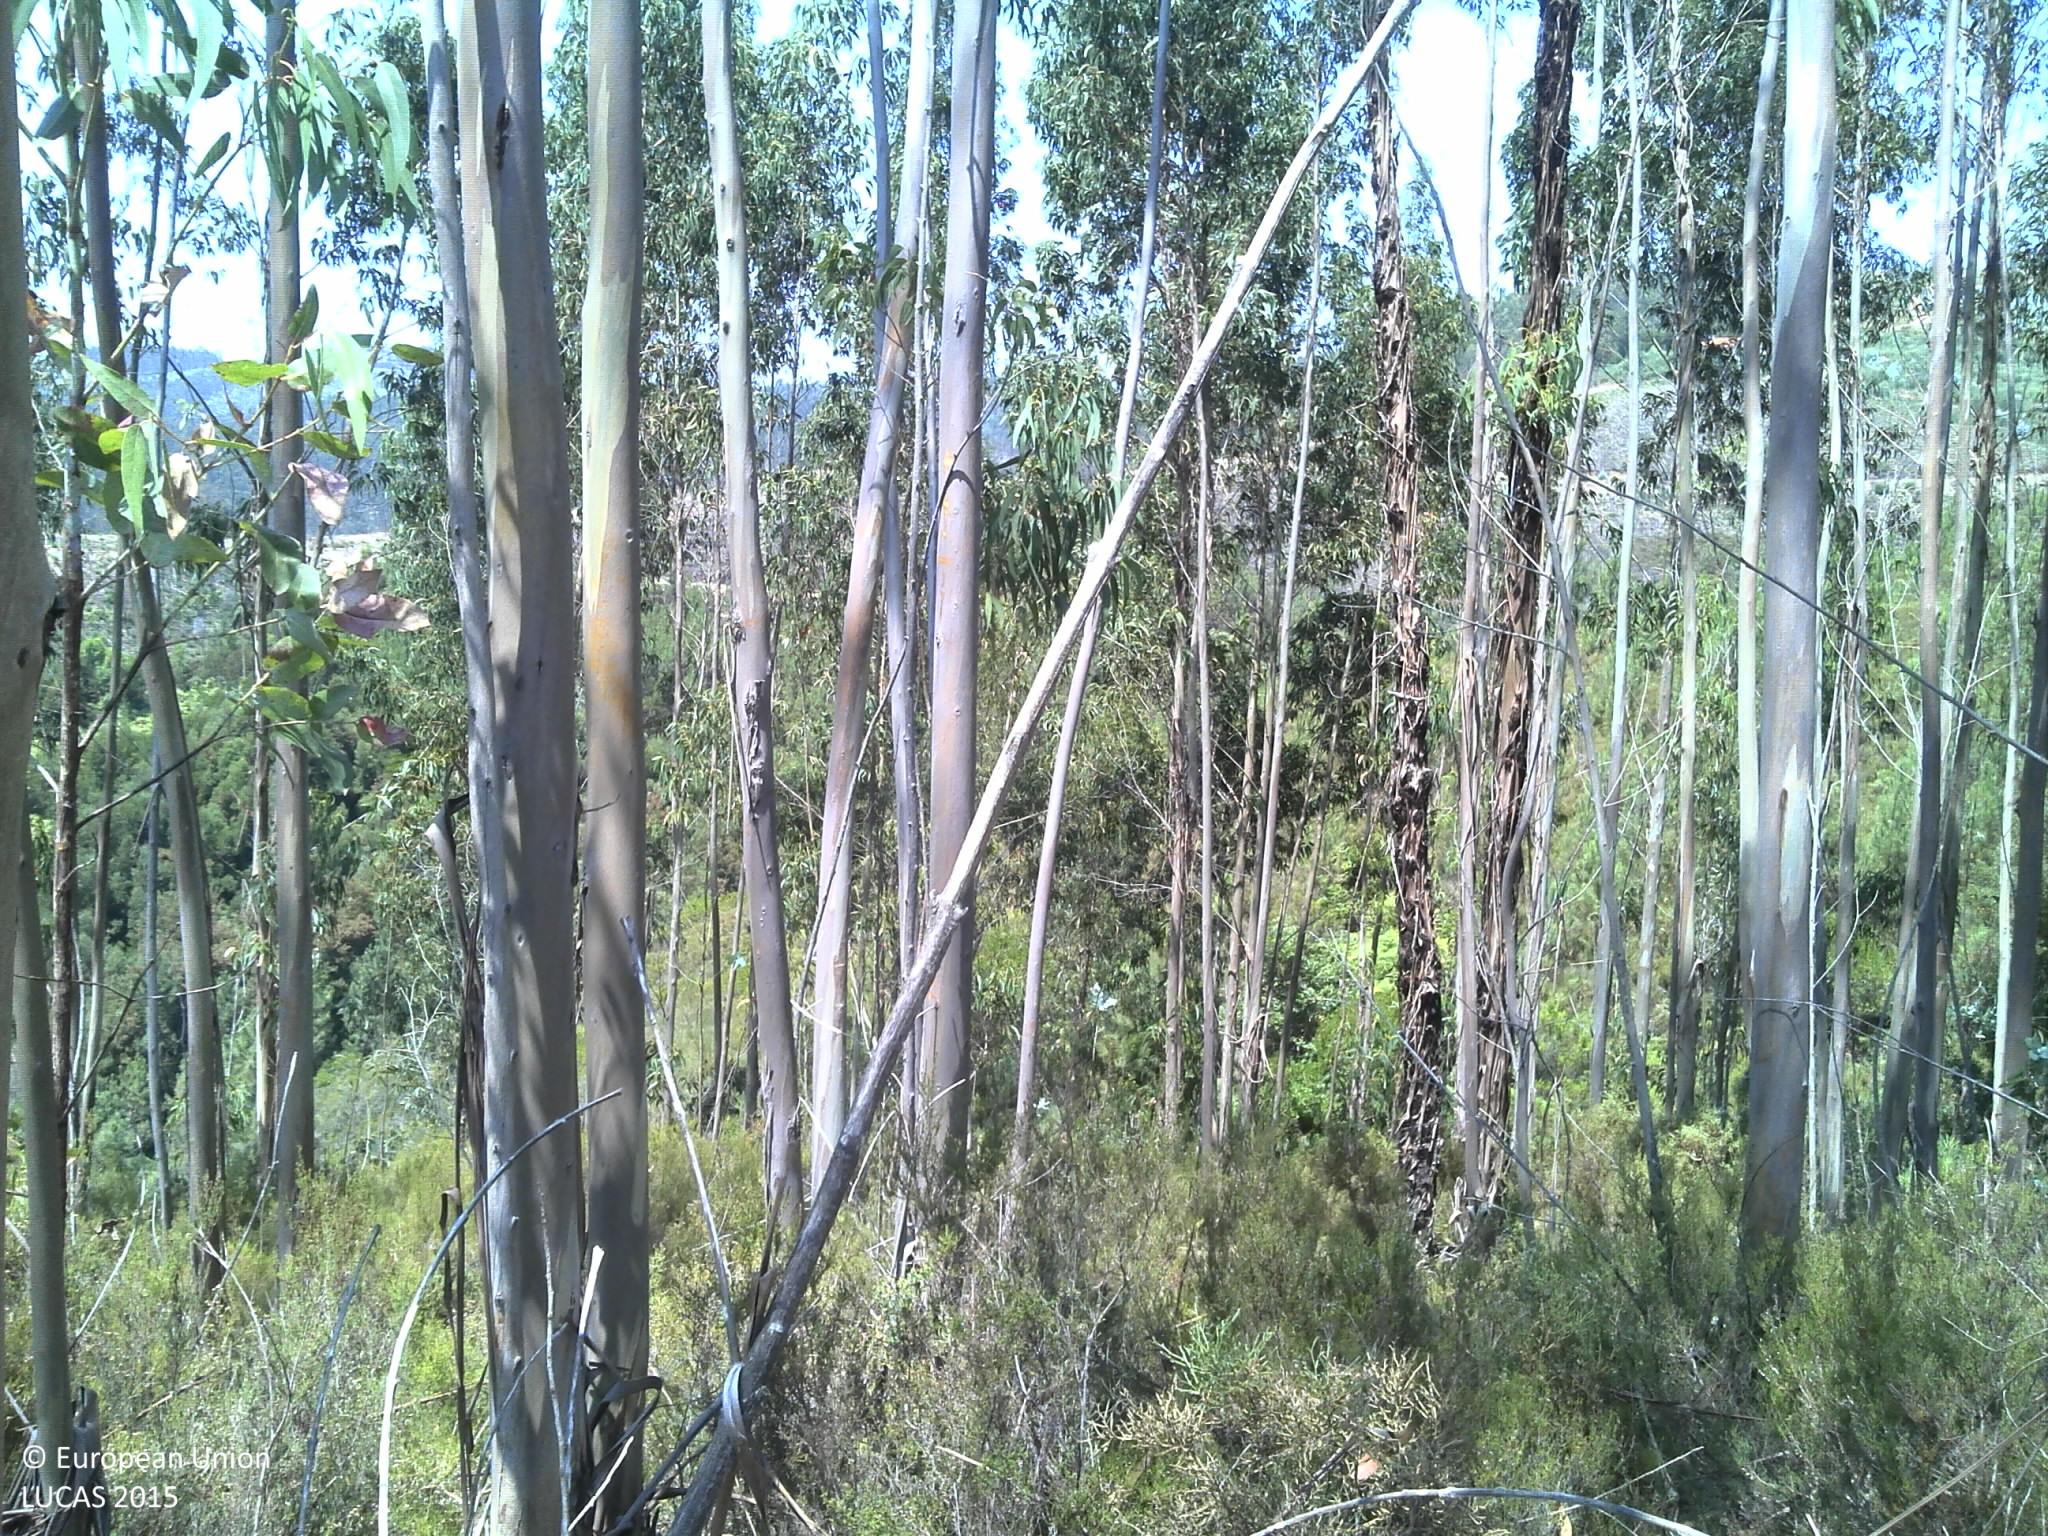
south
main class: Woodland
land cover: Broadleaved woodland
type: exotic forest
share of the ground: 50 - 75 %
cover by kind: broadleaved forest trees 70 %, shrubs 25 %, unconsolidated bare surface 5 %
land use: Forestry
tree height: > 5 m
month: July
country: PT
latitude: 40.6270
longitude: -8.3539
